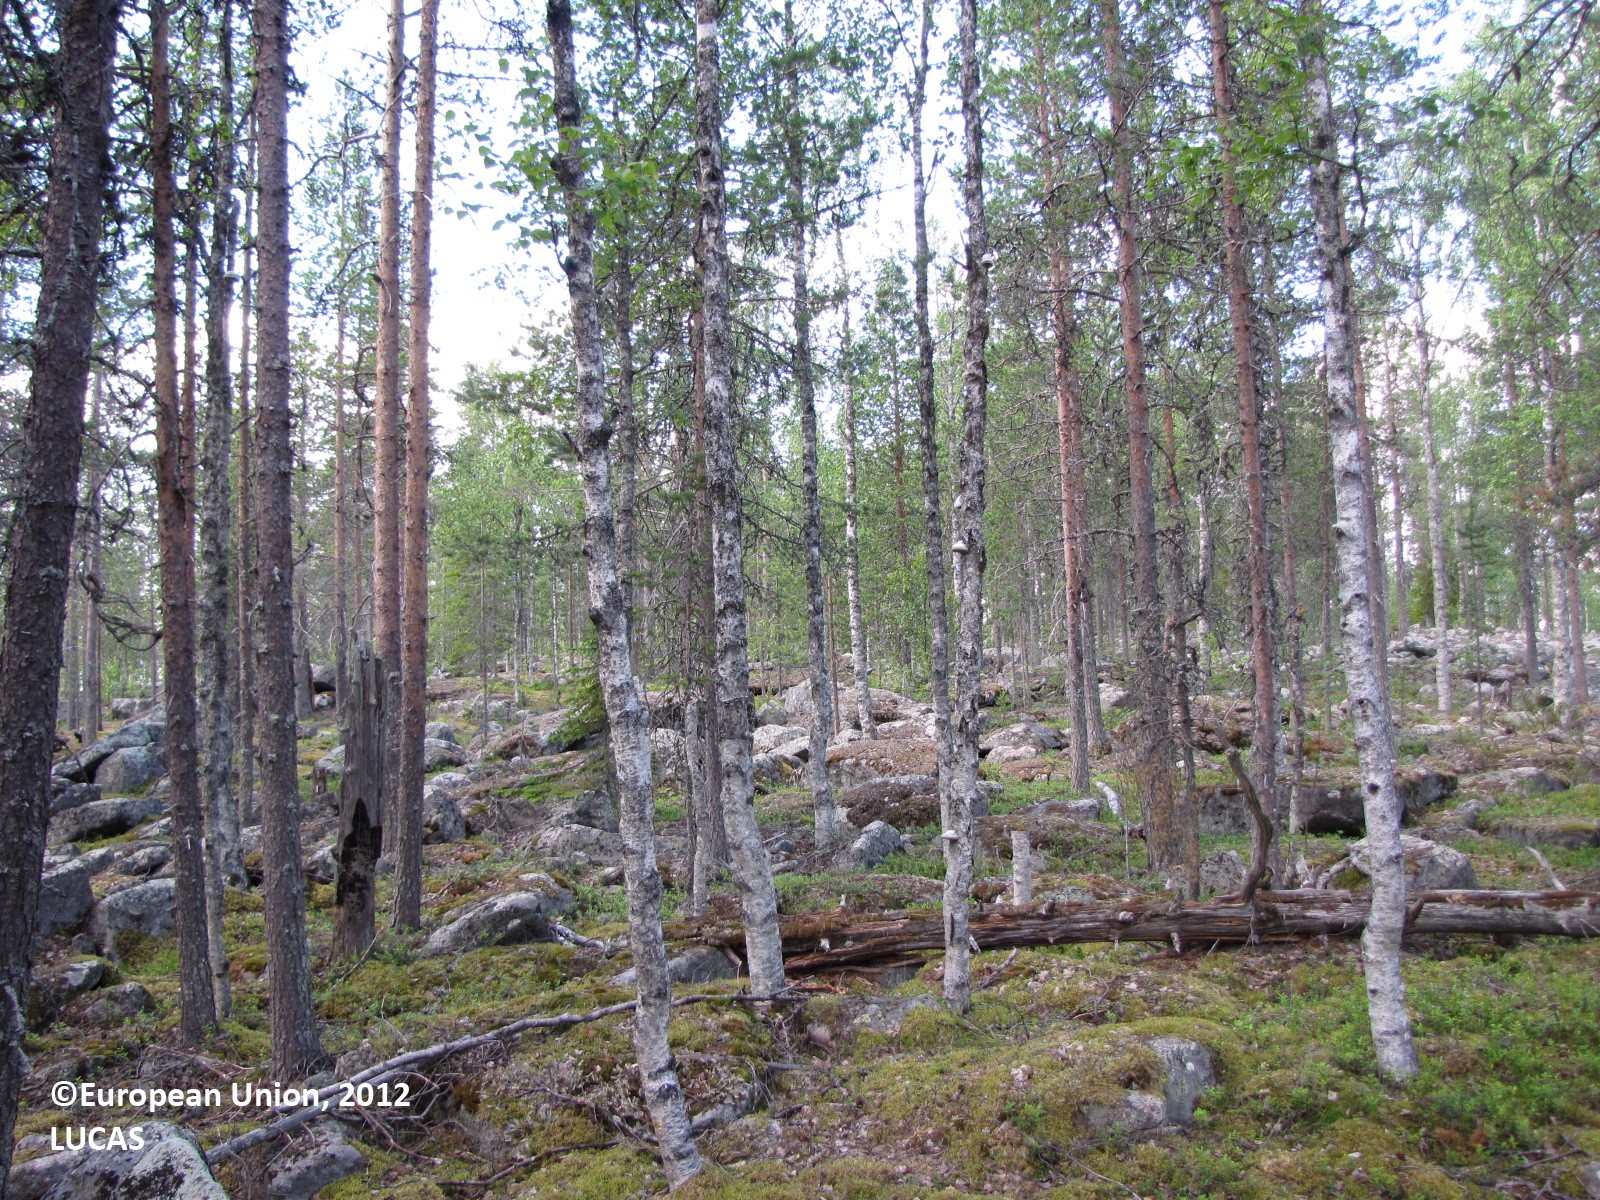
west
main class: Woodland
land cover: Pine dominated mixed woodland
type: boreal forest
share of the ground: 50 - 75 %
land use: Forestry
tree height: > 5 m
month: July
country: FI
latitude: 66.5139
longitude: 24.5033
